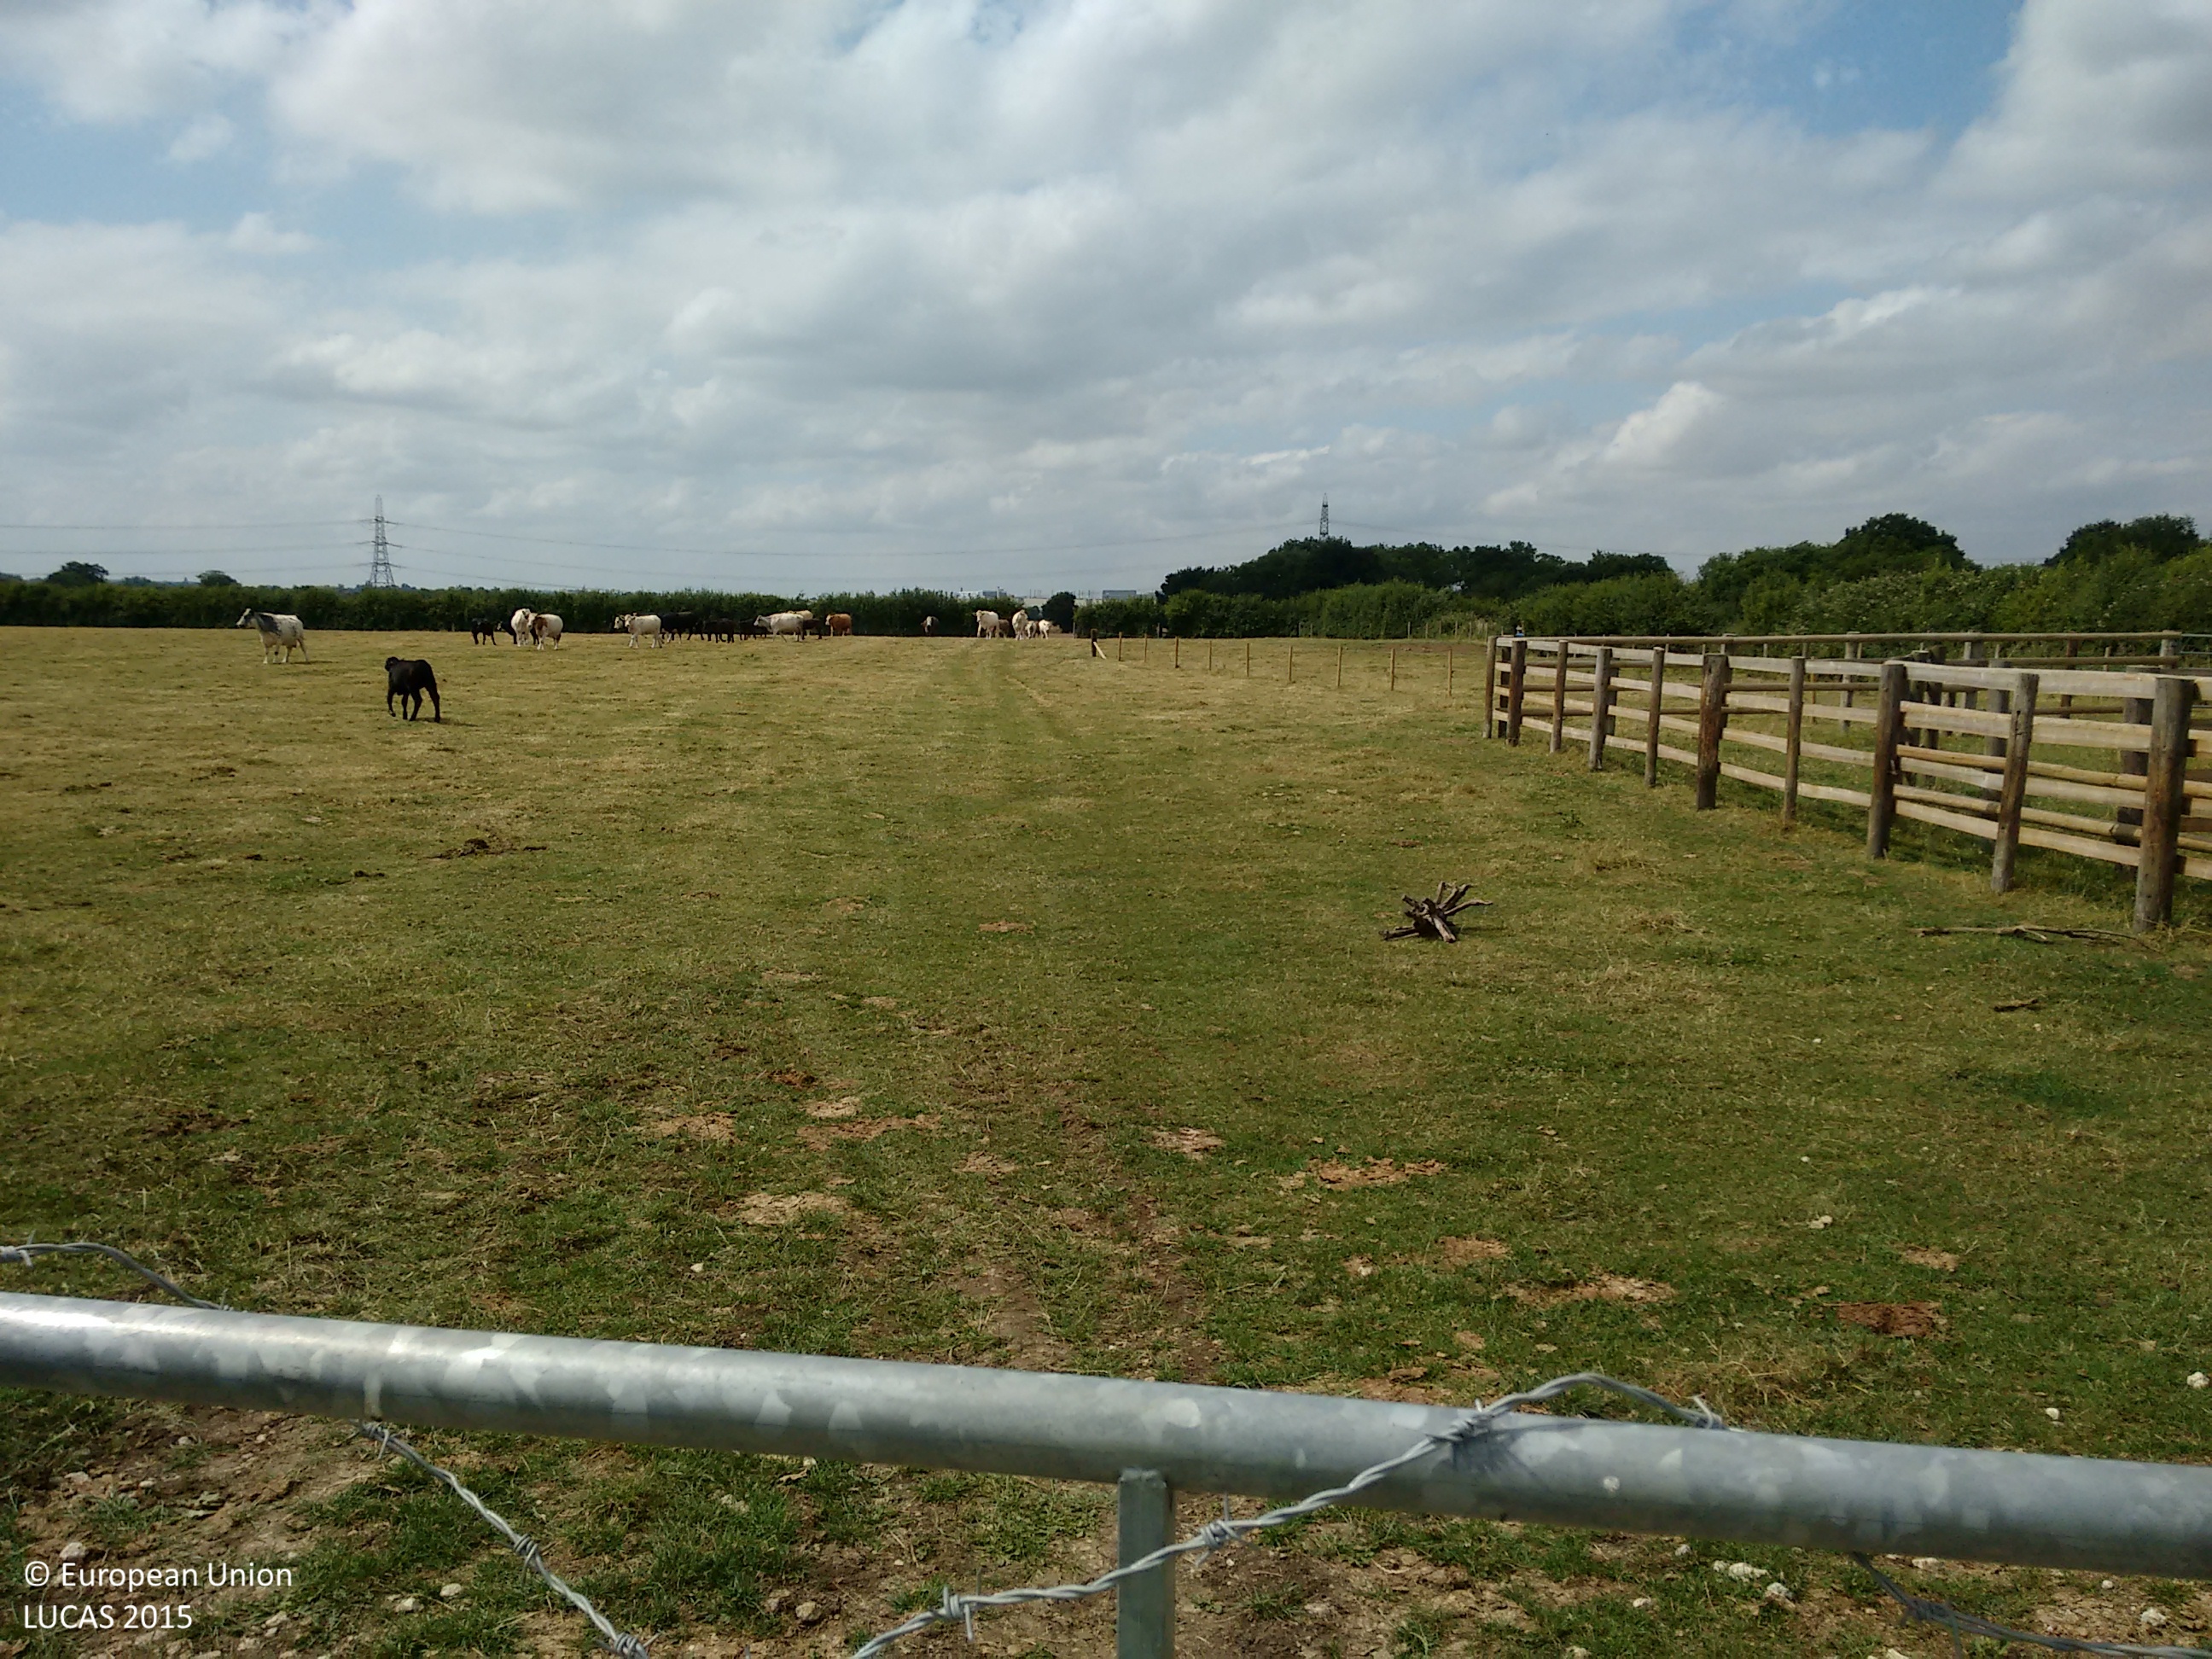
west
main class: Grassland
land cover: Grassland without tree/shrub cover
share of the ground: > 75 %
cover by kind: herbaceous plants 100 %
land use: Agriculture (excluding fallow land and kitchen gardens)
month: July
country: GB
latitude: 51.7205
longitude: -1.1786
